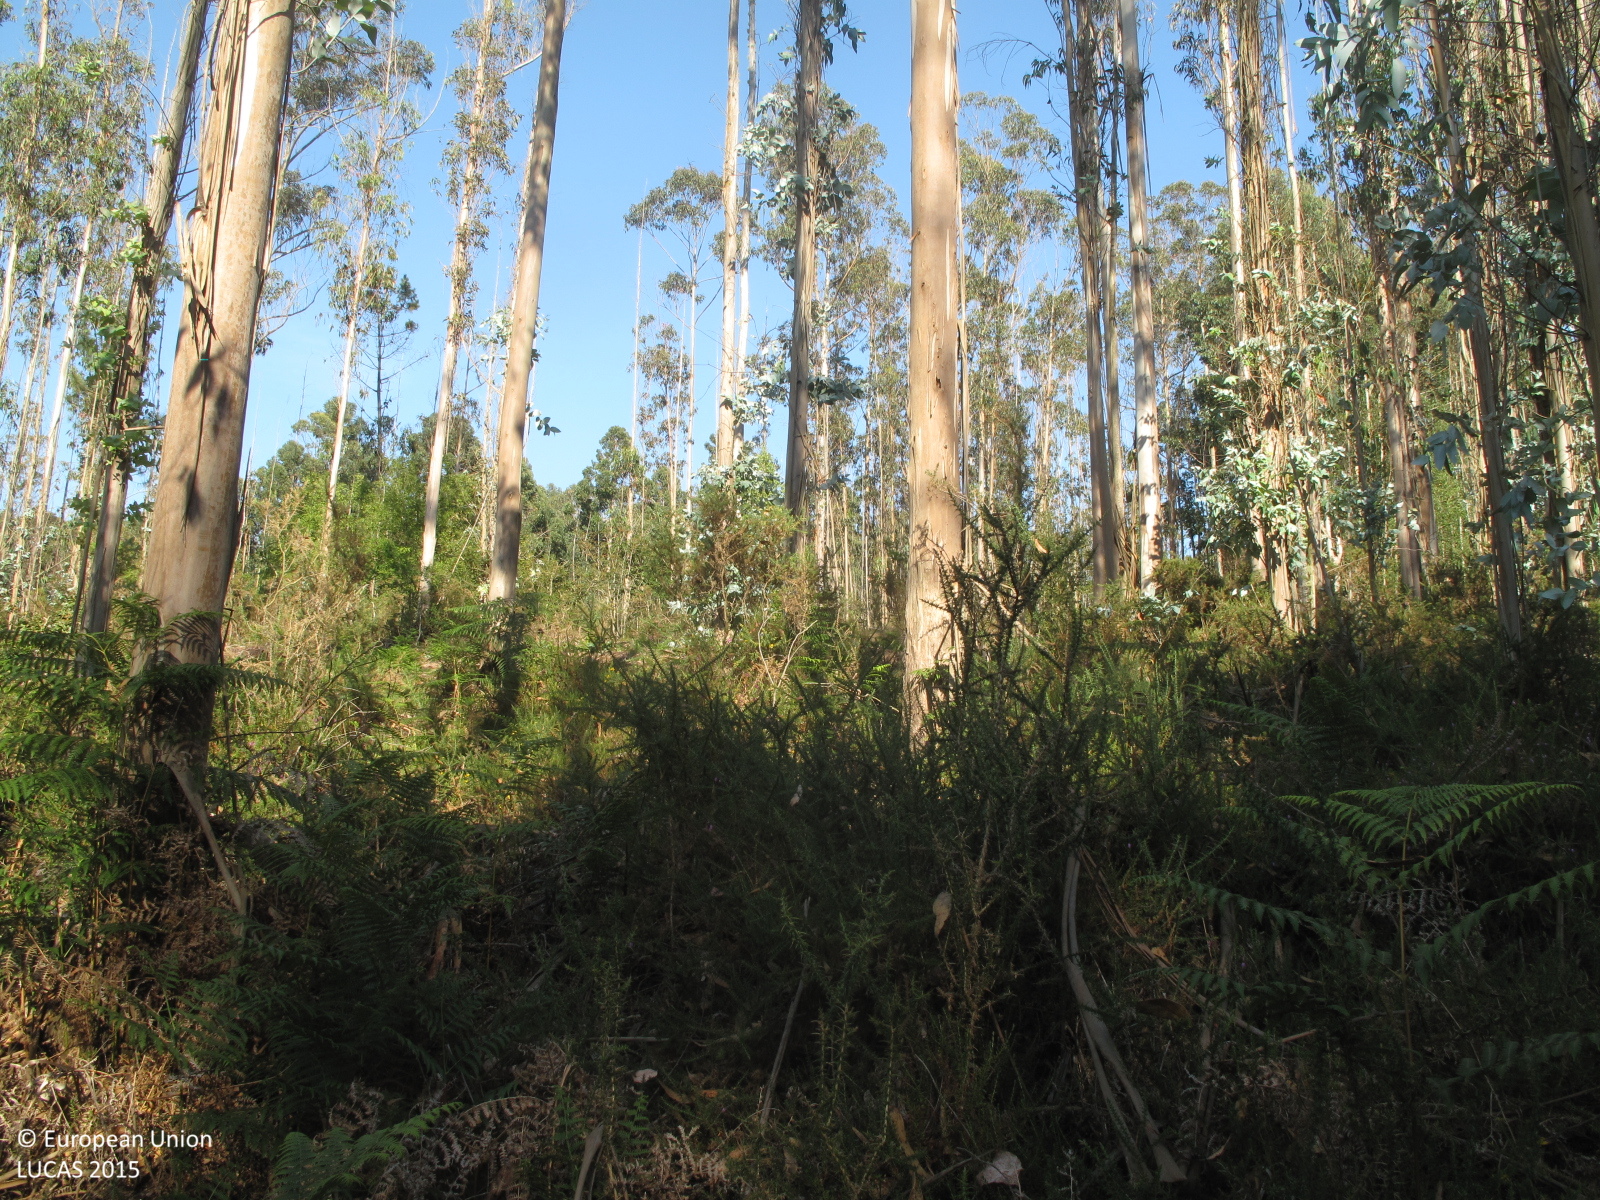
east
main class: Woodland
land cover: Broadleaved woodland
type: exotic forest
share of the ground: 25 - 50 %
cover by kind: shrubs 60 %, broadleaved forest trees 30 %, herbaceous plants 10 %
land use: Forestry
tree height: > 5 m
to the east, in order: Broadleaved woodland; Grassland with sparse tree/shrub cover; Broadleaved woodland
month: July
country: ES
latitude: 43.3169
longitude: -8.0863
